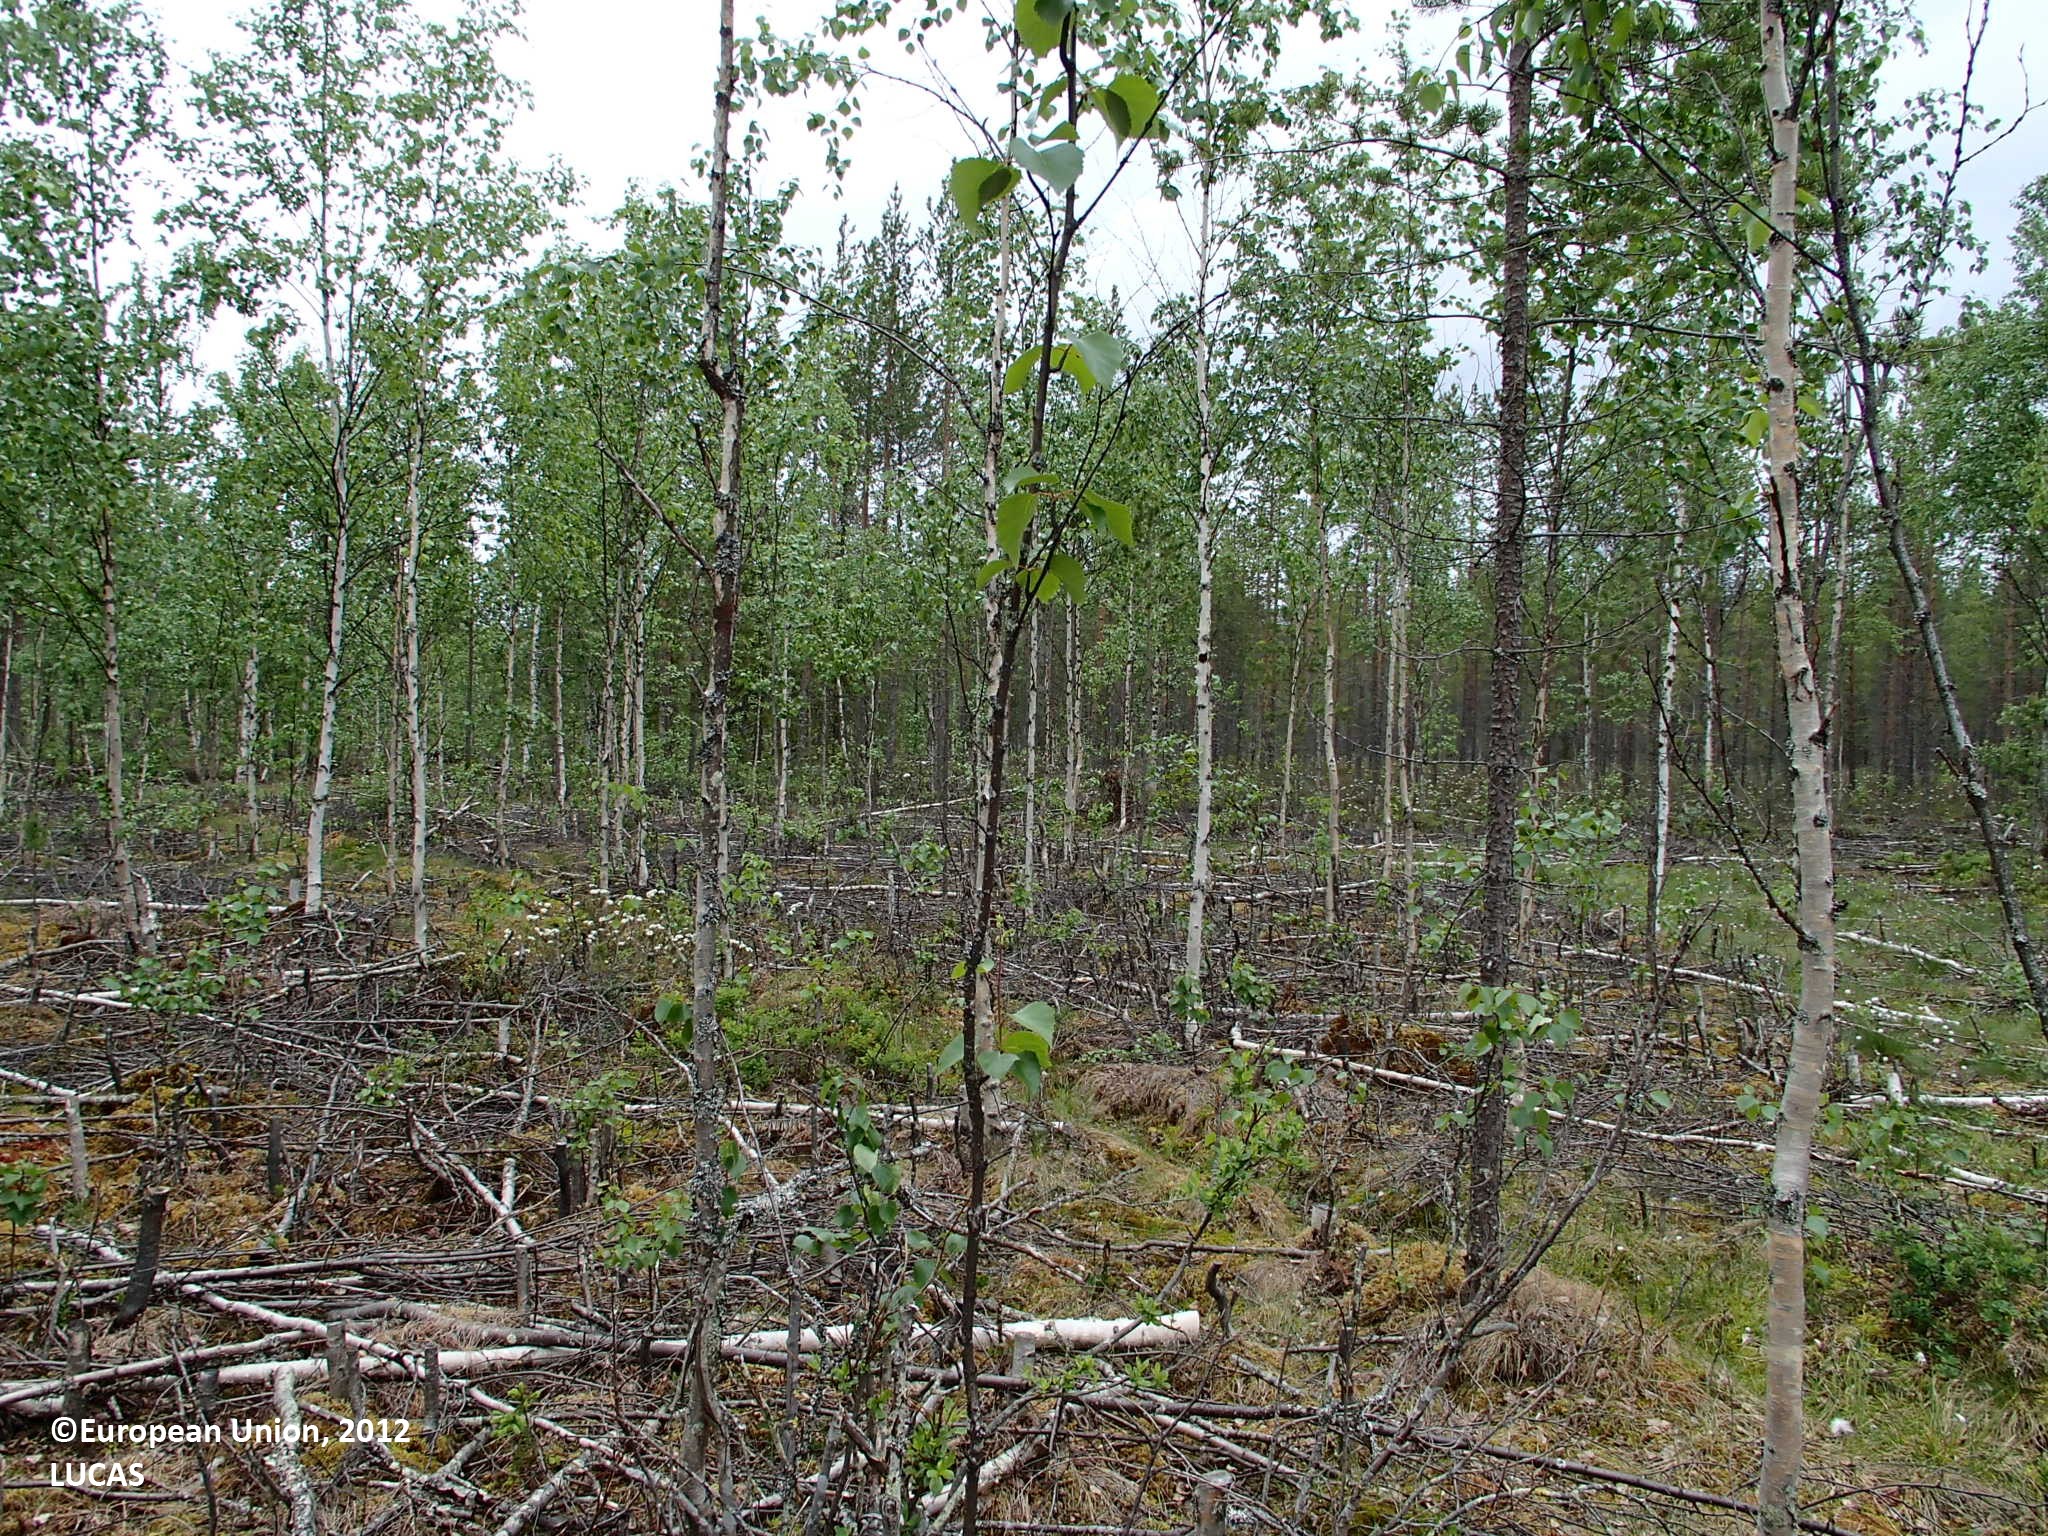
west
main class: Woodland
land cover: Pine dominated mixed woodland
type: boreal forest
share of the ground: 25 - 50 %
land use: Forestry
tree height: > 5 m
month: June
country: FI
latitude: 66.4955
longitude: 27.2517
